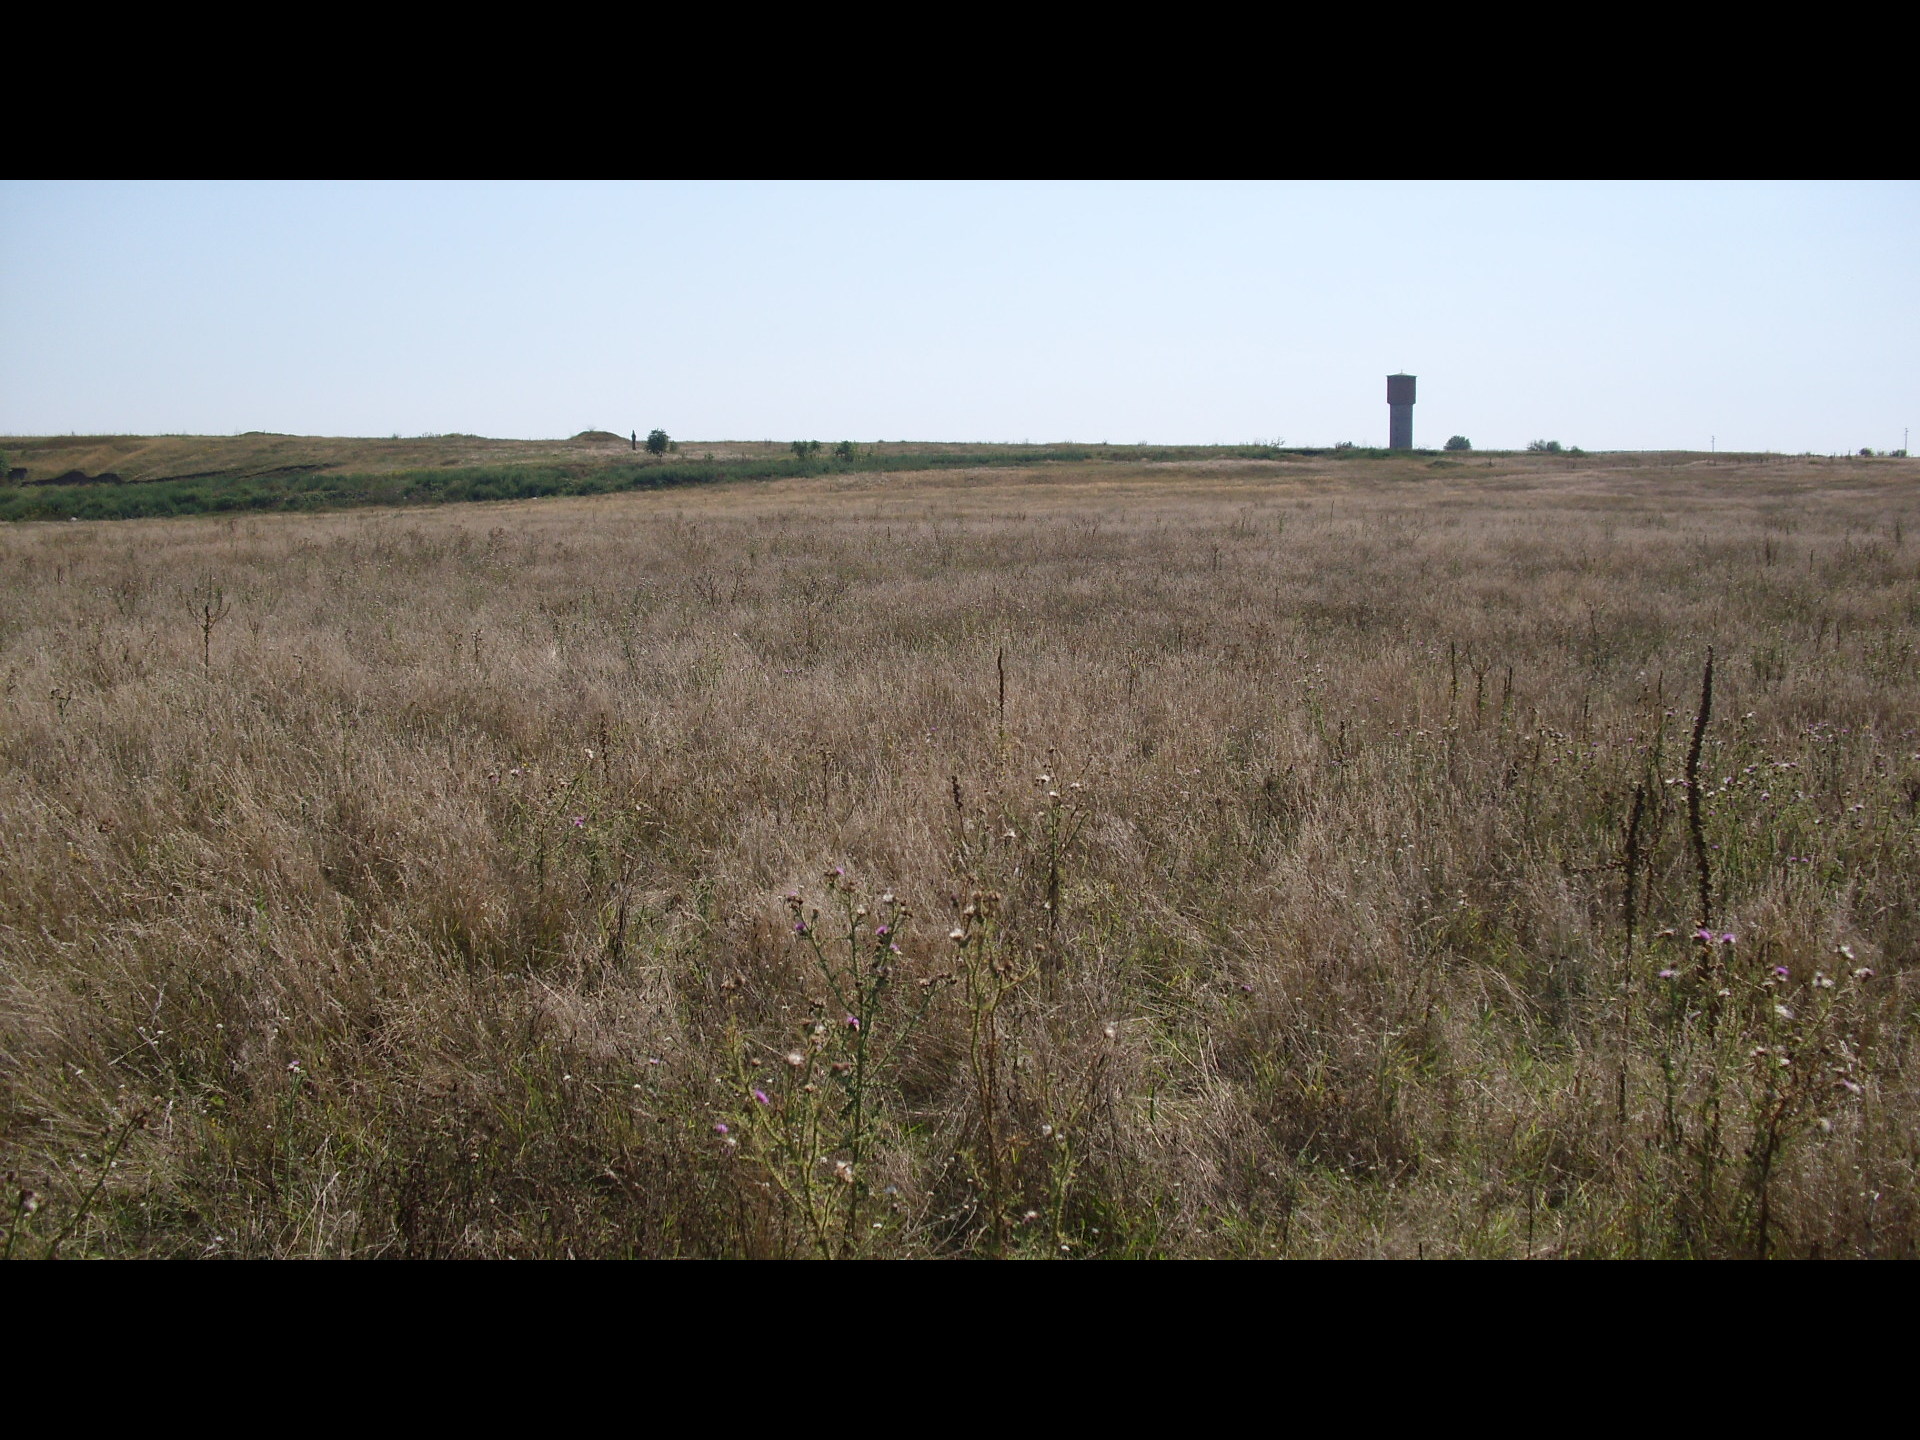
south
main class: Grassland
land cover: Grassland without tree/shrub cover
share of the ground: > 75 %
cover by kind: herbaceous plants 100 %
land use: Agriculture (excluding fallow land and kitchen gardens)
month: August
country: BG
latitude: 44.1561
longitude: 22.6540
